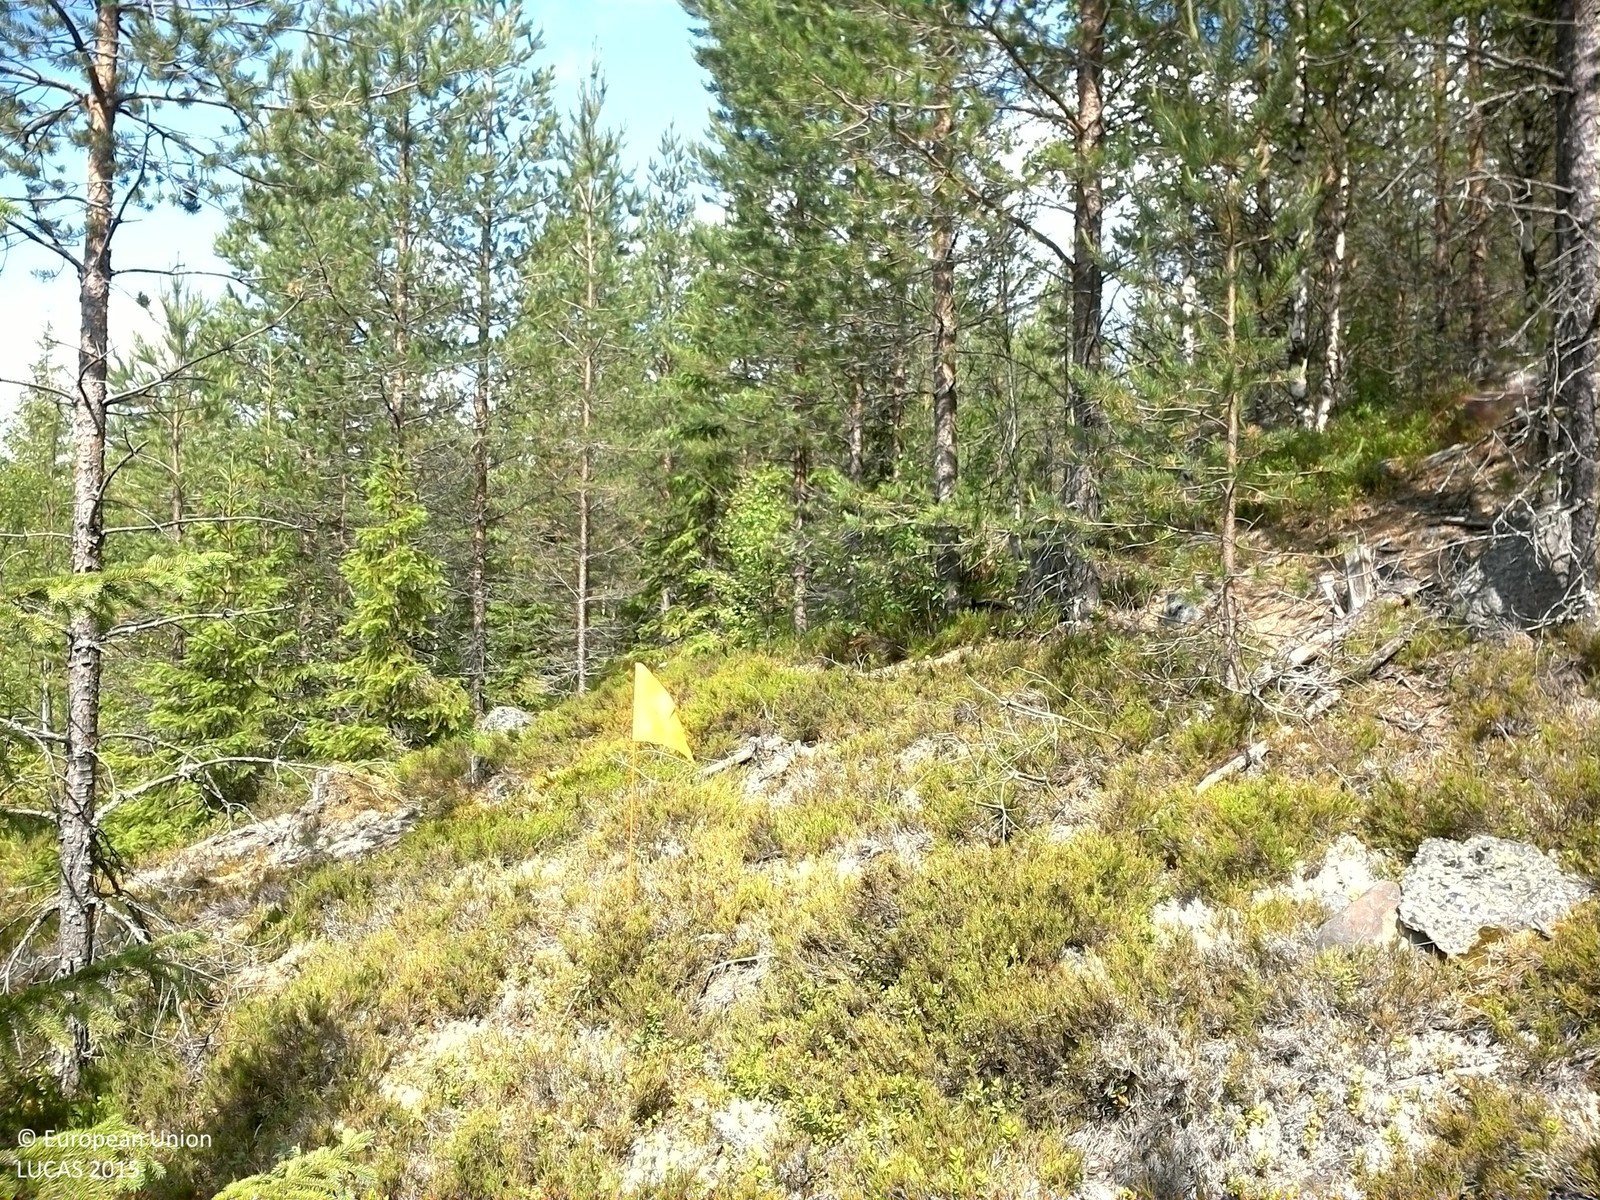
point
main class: Woodland
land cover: Pine dominated coniferous woodland
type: boreal forest
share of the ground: 50 - 75 %
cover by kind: coniferous forest trees 45 %, shrubs 25 %, lichens and mosses 25 %, broadleaved forest trees 5 %
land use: Forestry
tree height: > 5 m
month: July
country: SE
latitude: 63.5466
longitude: 17.5592
